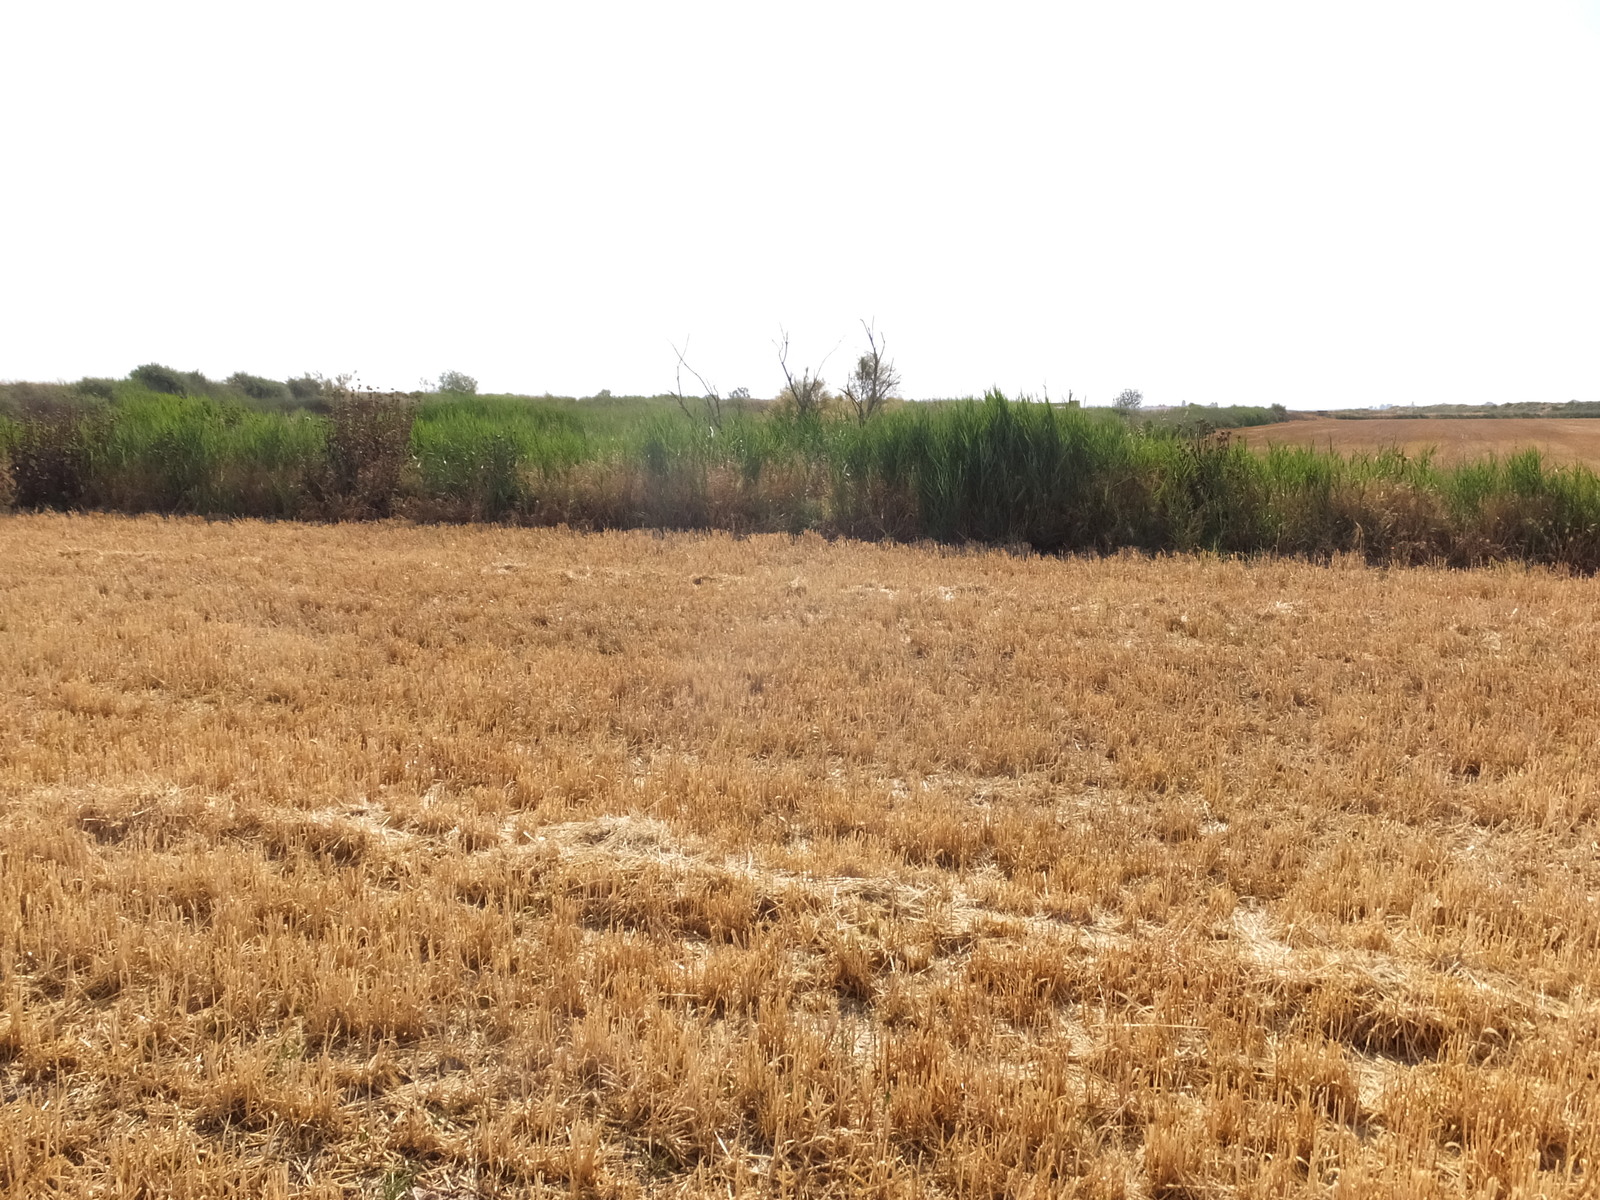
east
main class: Cropland
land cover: Barley
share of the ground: < 10 %
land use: Agriculture (excluding fallow land and kitchen gardens)
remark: Harvested field
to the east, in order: Barley; Grass margins; Barley; Grass margins; Barley; Grass margins; Ditches and canals; Grass margins; Barley; Grass margins; Single bushes/trees; Barley
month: June
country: ES
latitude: 41.7615
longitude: 0.0363
